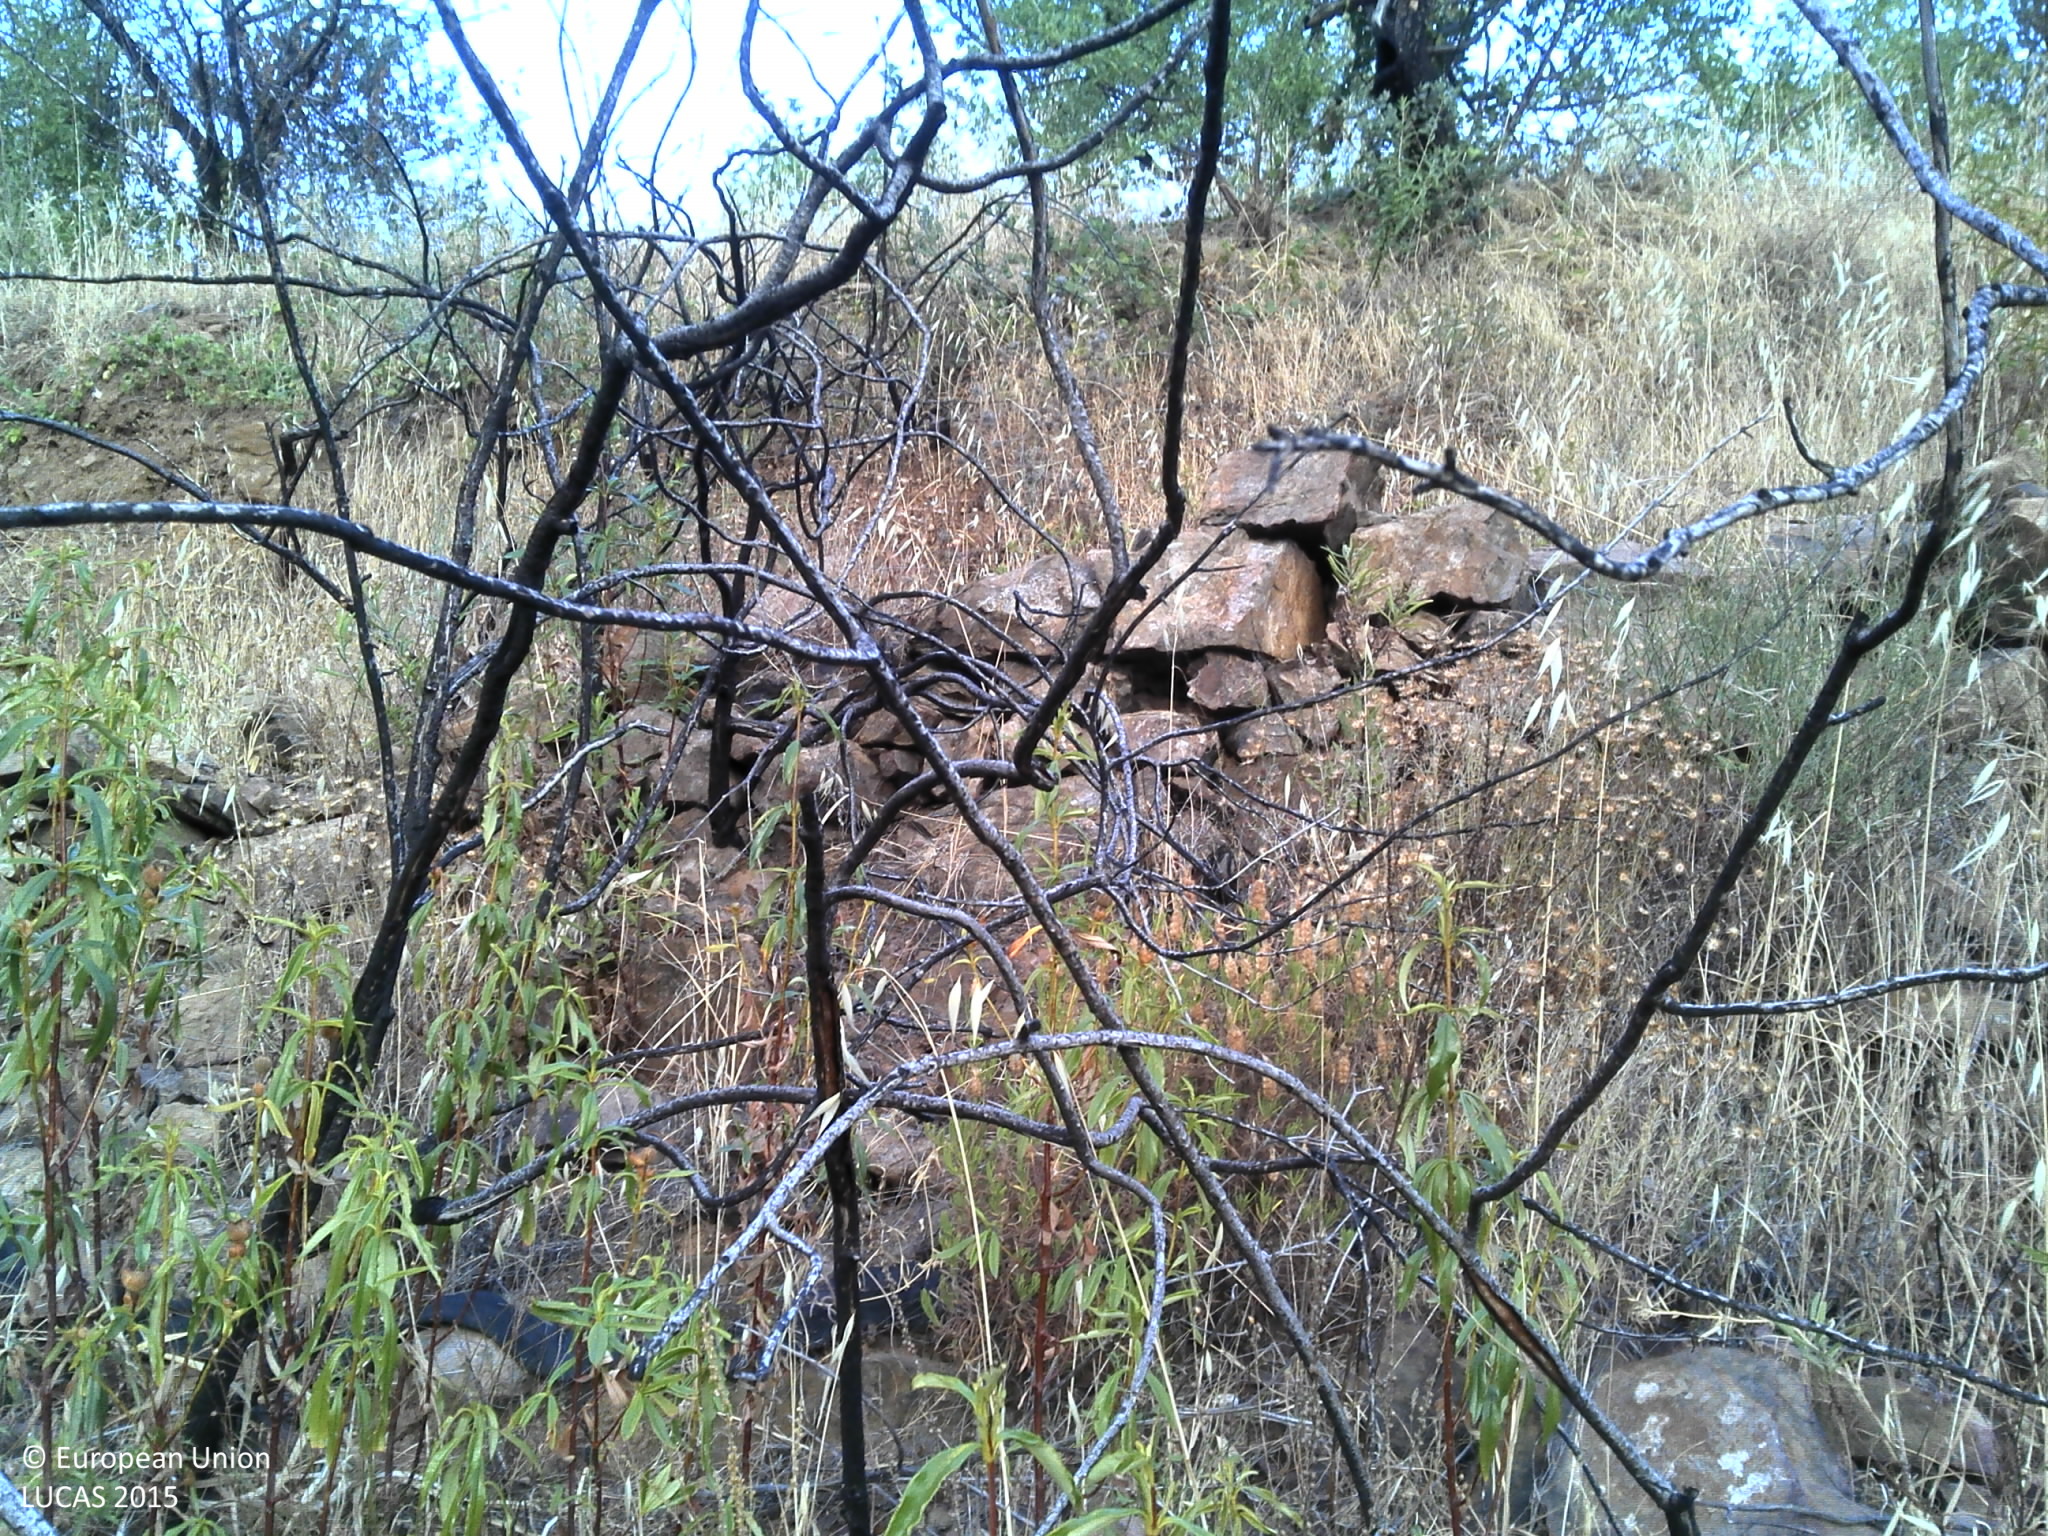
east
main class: Shrubland
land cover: Shrubland without tree cover
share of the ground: 50 - 75 %
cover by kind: shrubs 75 %, unconsolidated bare surface 15 %, herbaceous plants 10 %
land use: Abandoned areas
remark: Burnt area
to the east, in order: Shrubland without tree cover; Dry stone walls; Grassland with sparse tree/shrub cover; Other fruit trees and berries; Electric lines; Shrubland without tree cover; Tracks; Shrubland without tree cover; Grassland without tree/shrub cover; Shrubland without tree cover; Electric lines; Shrubland without tree cover; Shrubland with sparse tree cover; Broadleaved woodland
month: June
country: PT
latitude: 37.1868
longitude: -7.6809
